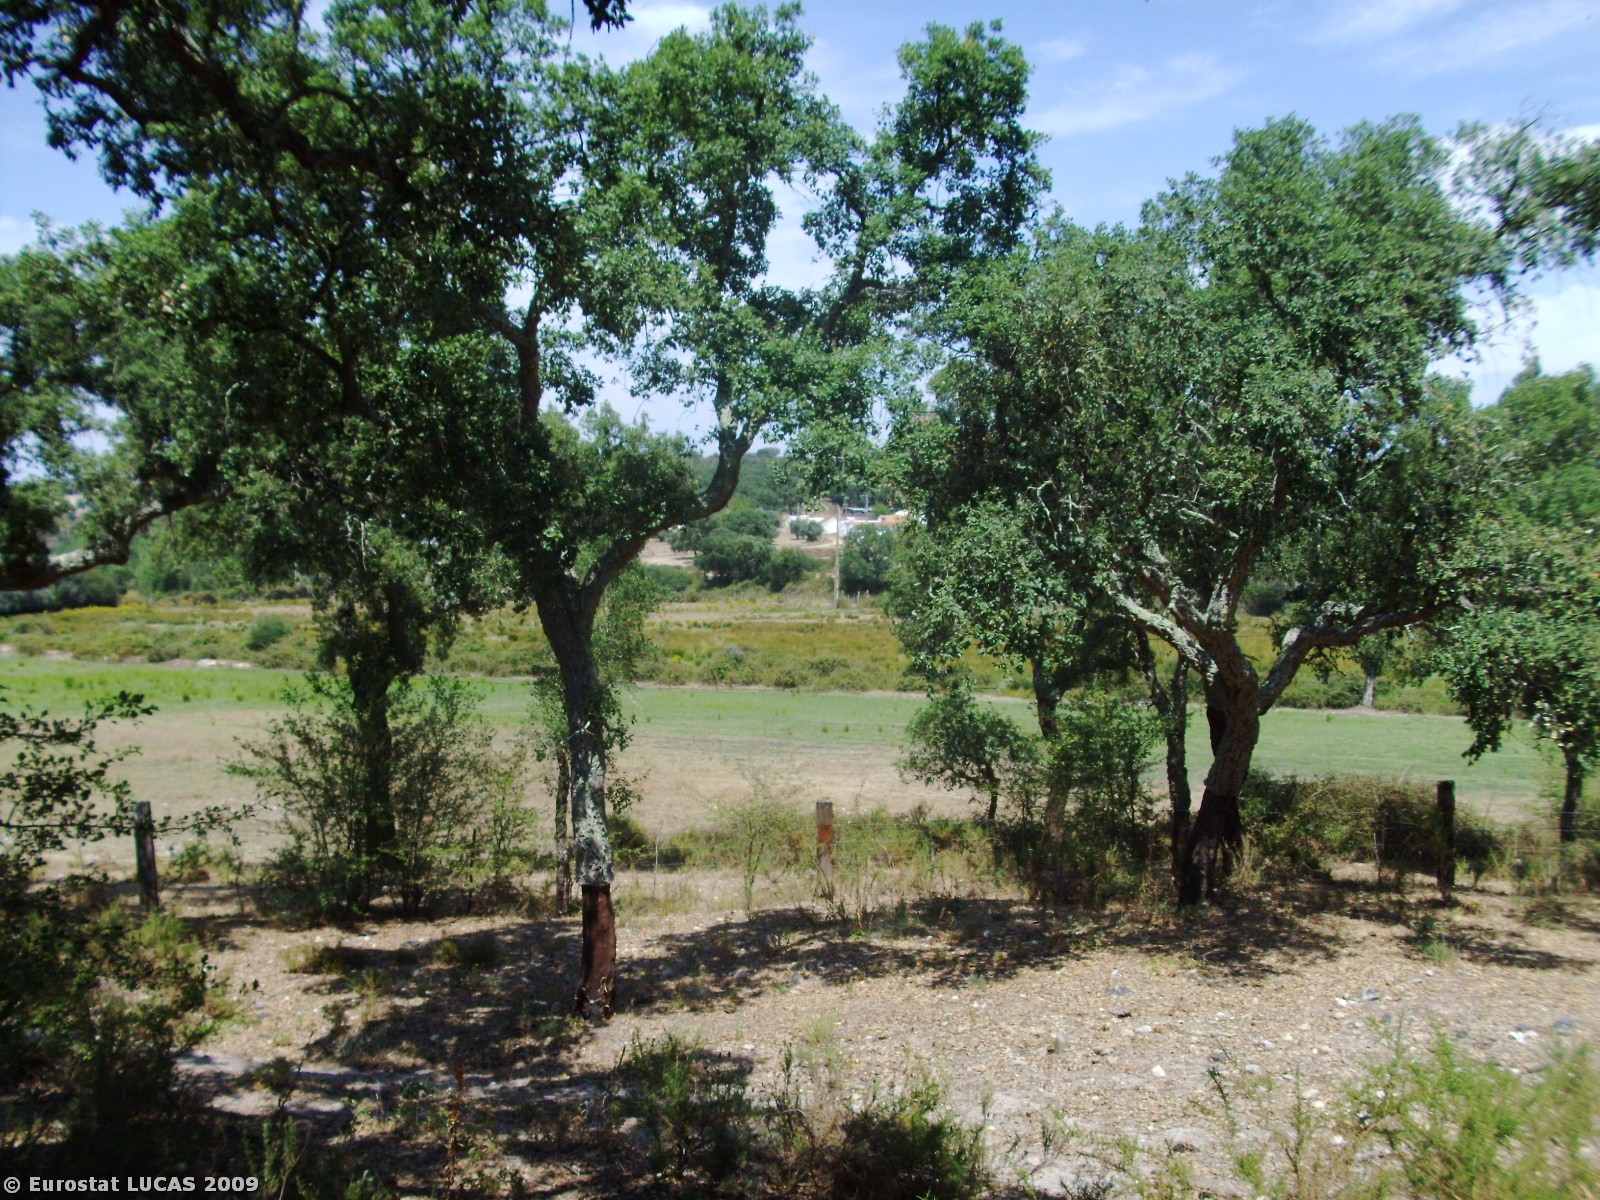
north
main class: Woodland
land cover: Broadleaved woodland
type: broadleaved evergreen forest
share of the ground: 50 - 75 %
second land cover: Spontaneously vegetated surfaces
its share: 10 - 25 %
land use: Forestry
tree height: > 5 m
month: August
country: PT
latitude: 39.3222
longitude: -8.1194
